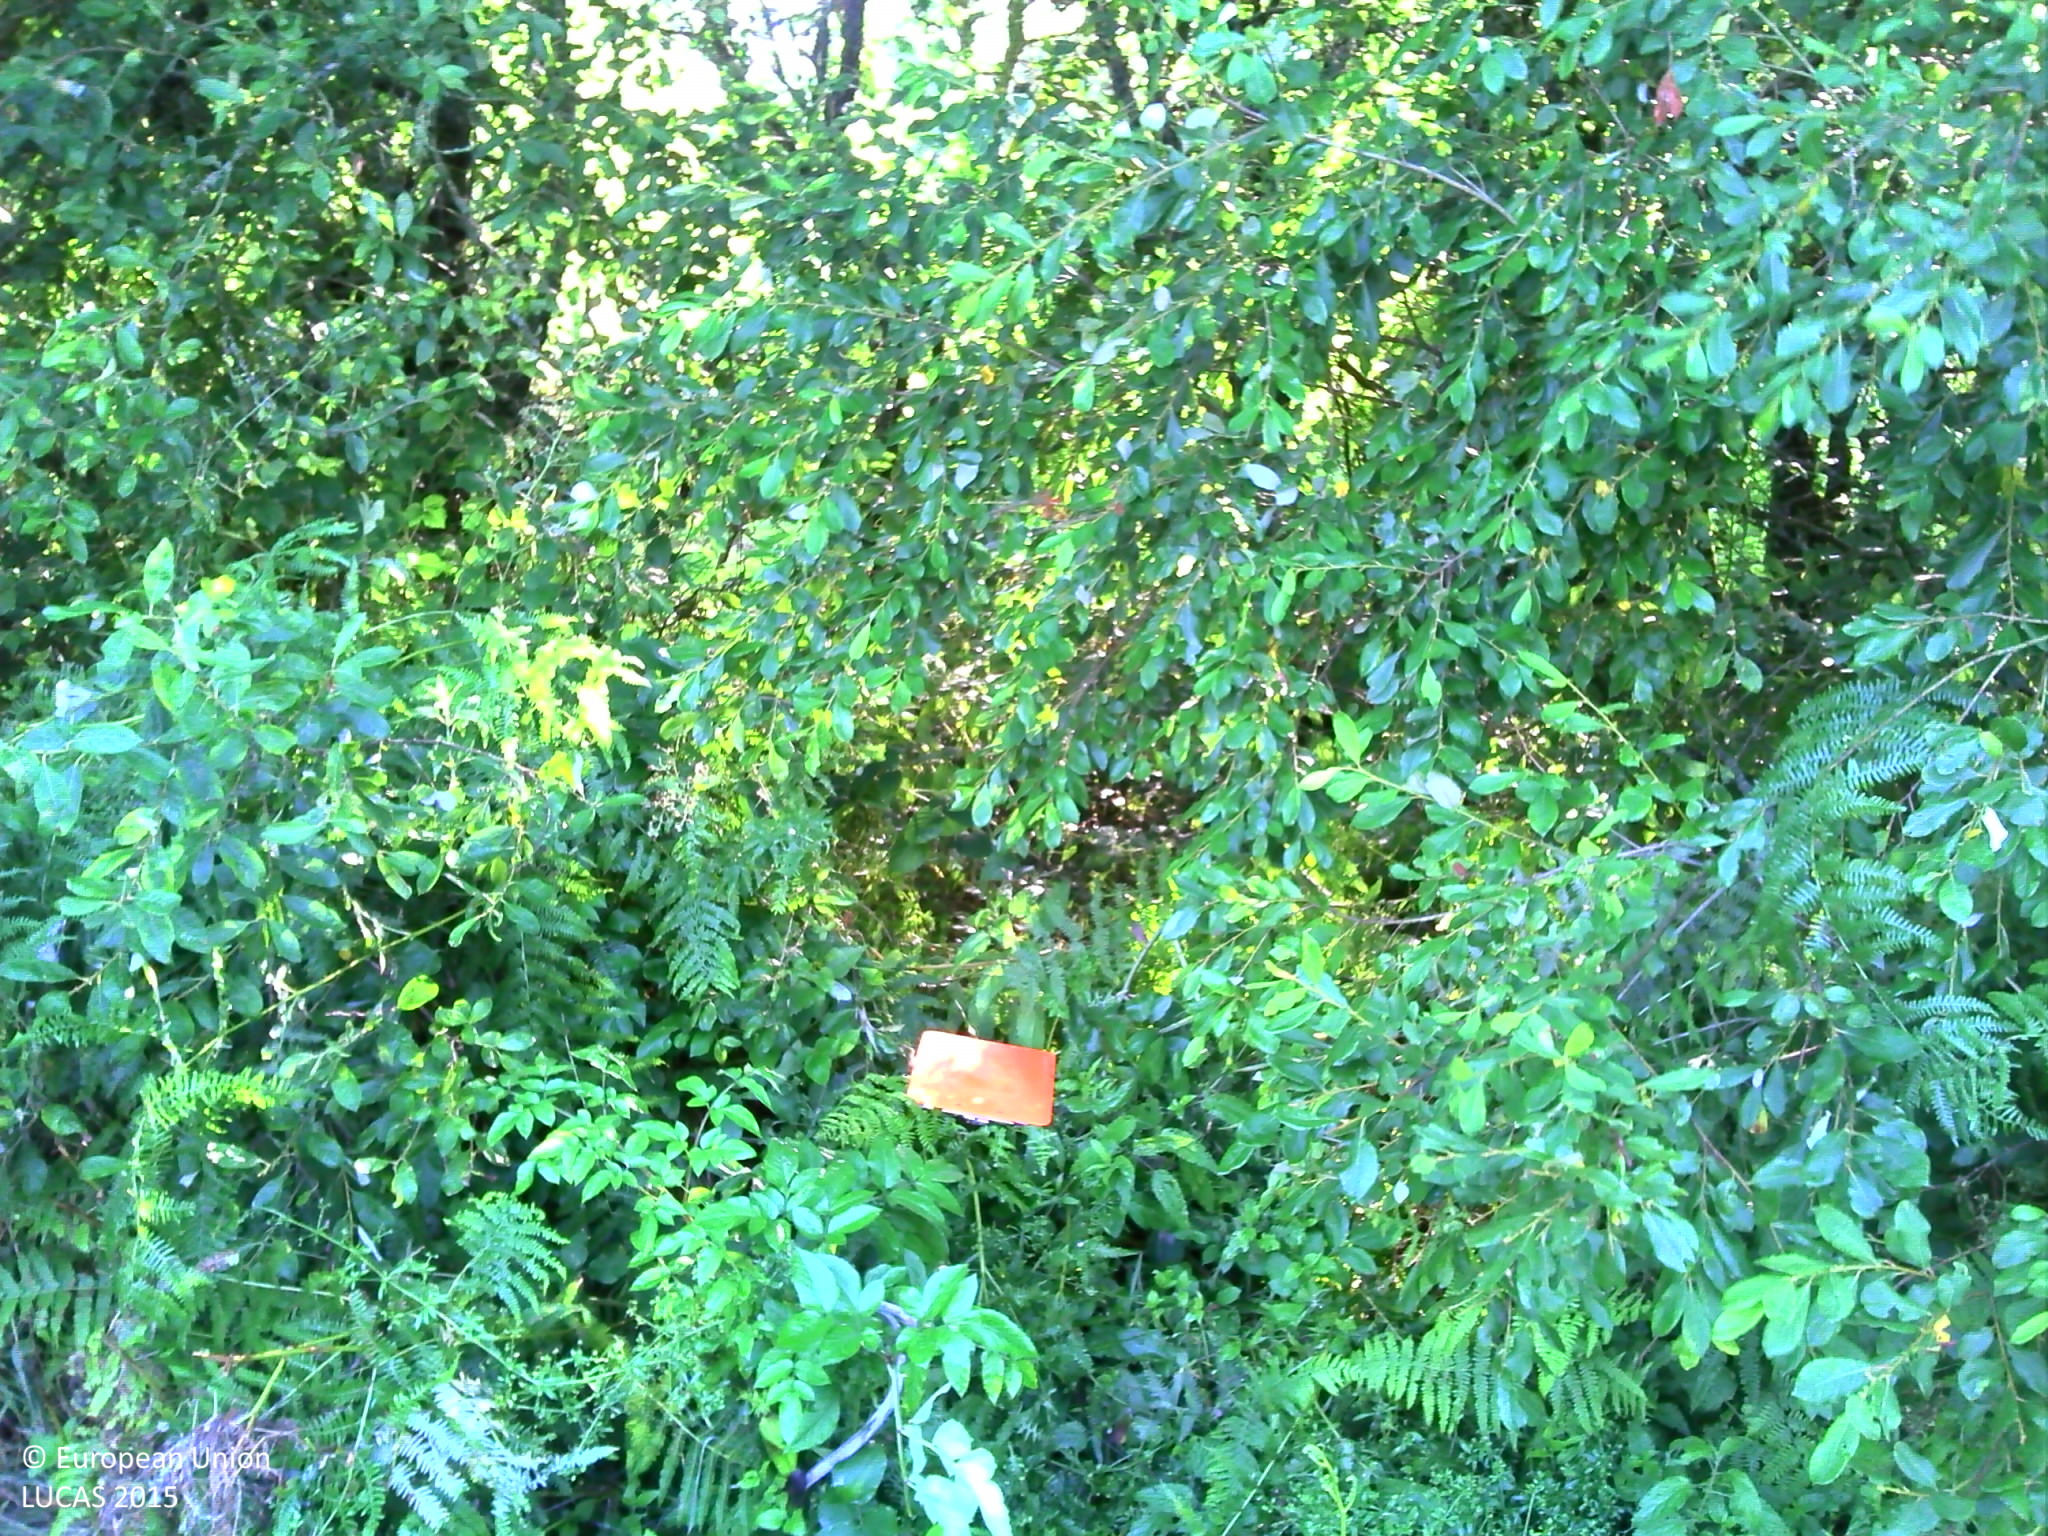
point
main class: Woodland
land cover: Broadleaved woodland
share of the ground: > 75 %
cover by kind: broadleaved forest trees 90 %, herbaceous plants 10 %
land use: Semi-natural and natural areas not in use
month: July
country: FR
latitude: 48.1621
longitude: -3.2897
